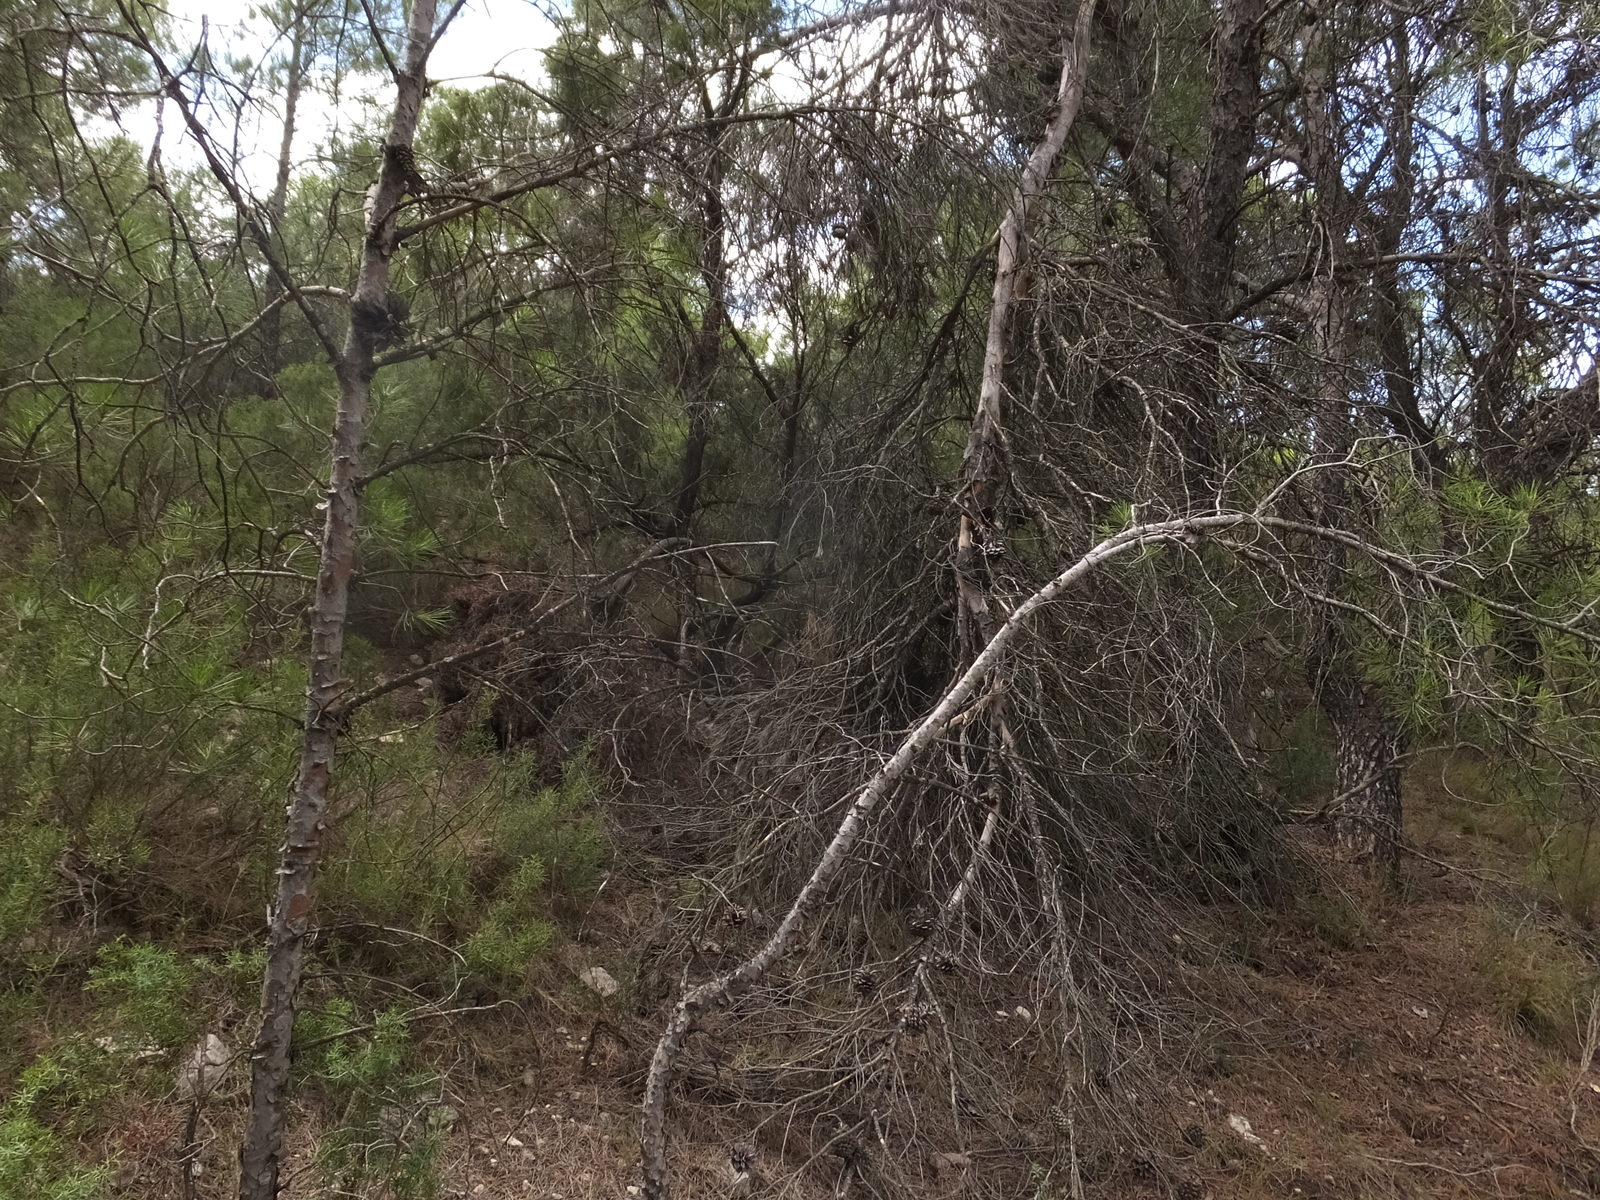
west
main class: Woodland
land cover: Pine dominated mixed woodland
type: coniferous forest of the mediterranean region
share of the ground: 50 - 75 %
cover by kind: coniferous forest trees 60 %, broadleaved forest trees 20 %, shrubs 15 %, herbaceous plants 5 %
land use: Forestry
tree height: > 5 m
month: August
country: ES
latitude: 41.3412
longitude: 0.2005
